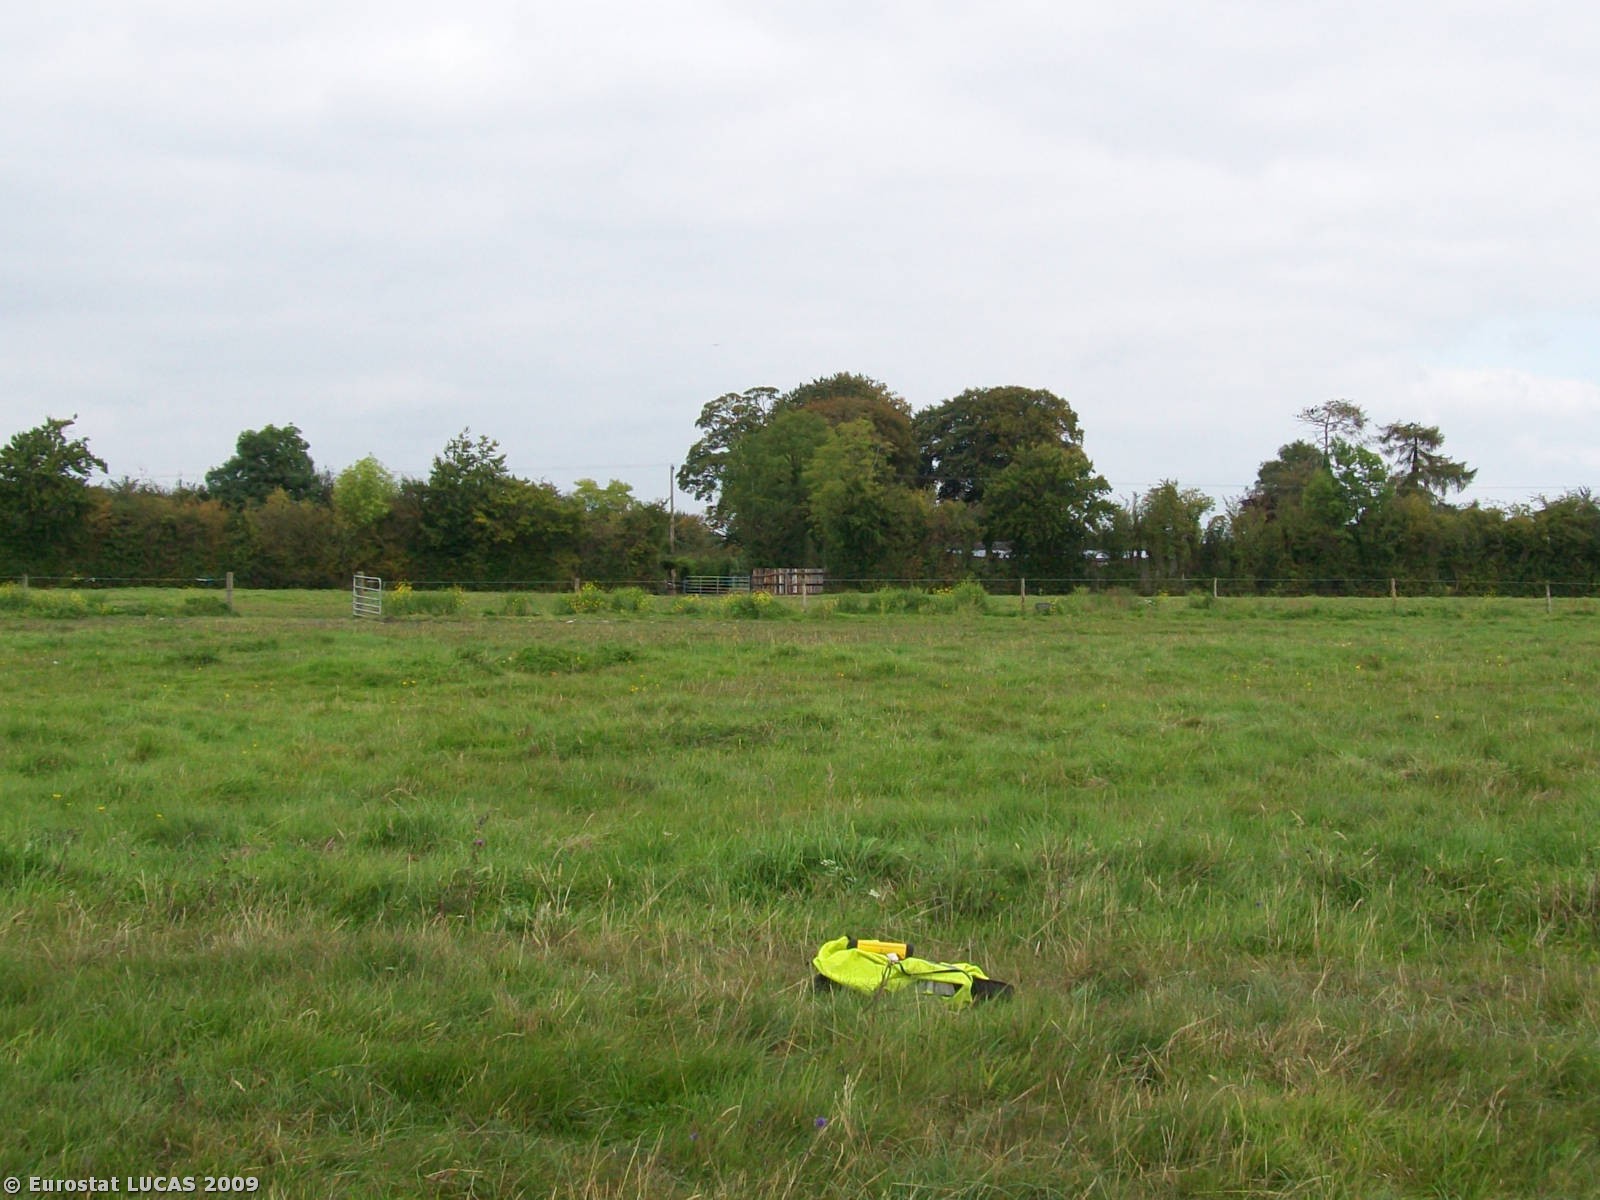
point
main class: Grassland
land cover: Grassland without tree/shrub cover
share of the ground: > 75 %
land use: Agriculture (excluding fallow land and kitchen gardens)
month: September
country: IE
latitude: 52.9599
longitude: -7.8717
